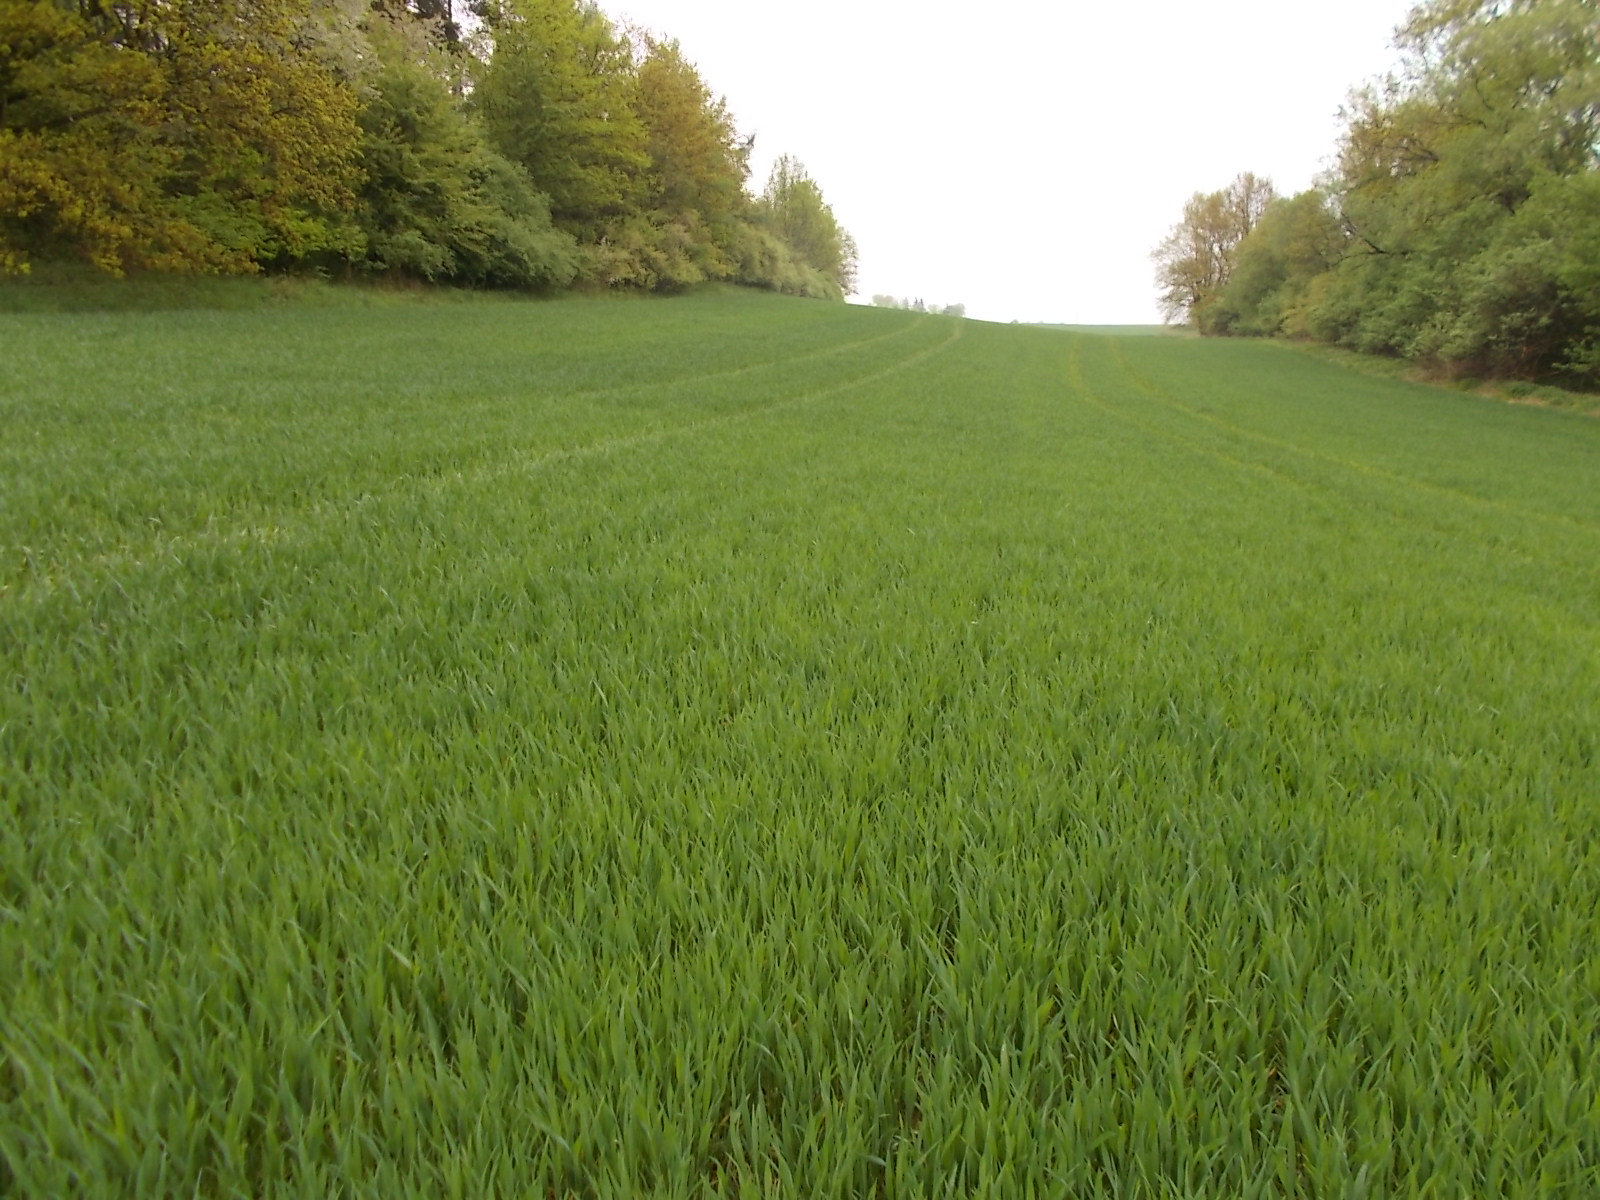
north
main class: Cropland
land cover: Common wheat
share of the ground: > 75 %
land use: Agriculture (excluding fallow land and kitchen gardens)
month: May
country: CZ
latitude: 50.0100
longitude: 17.7584
